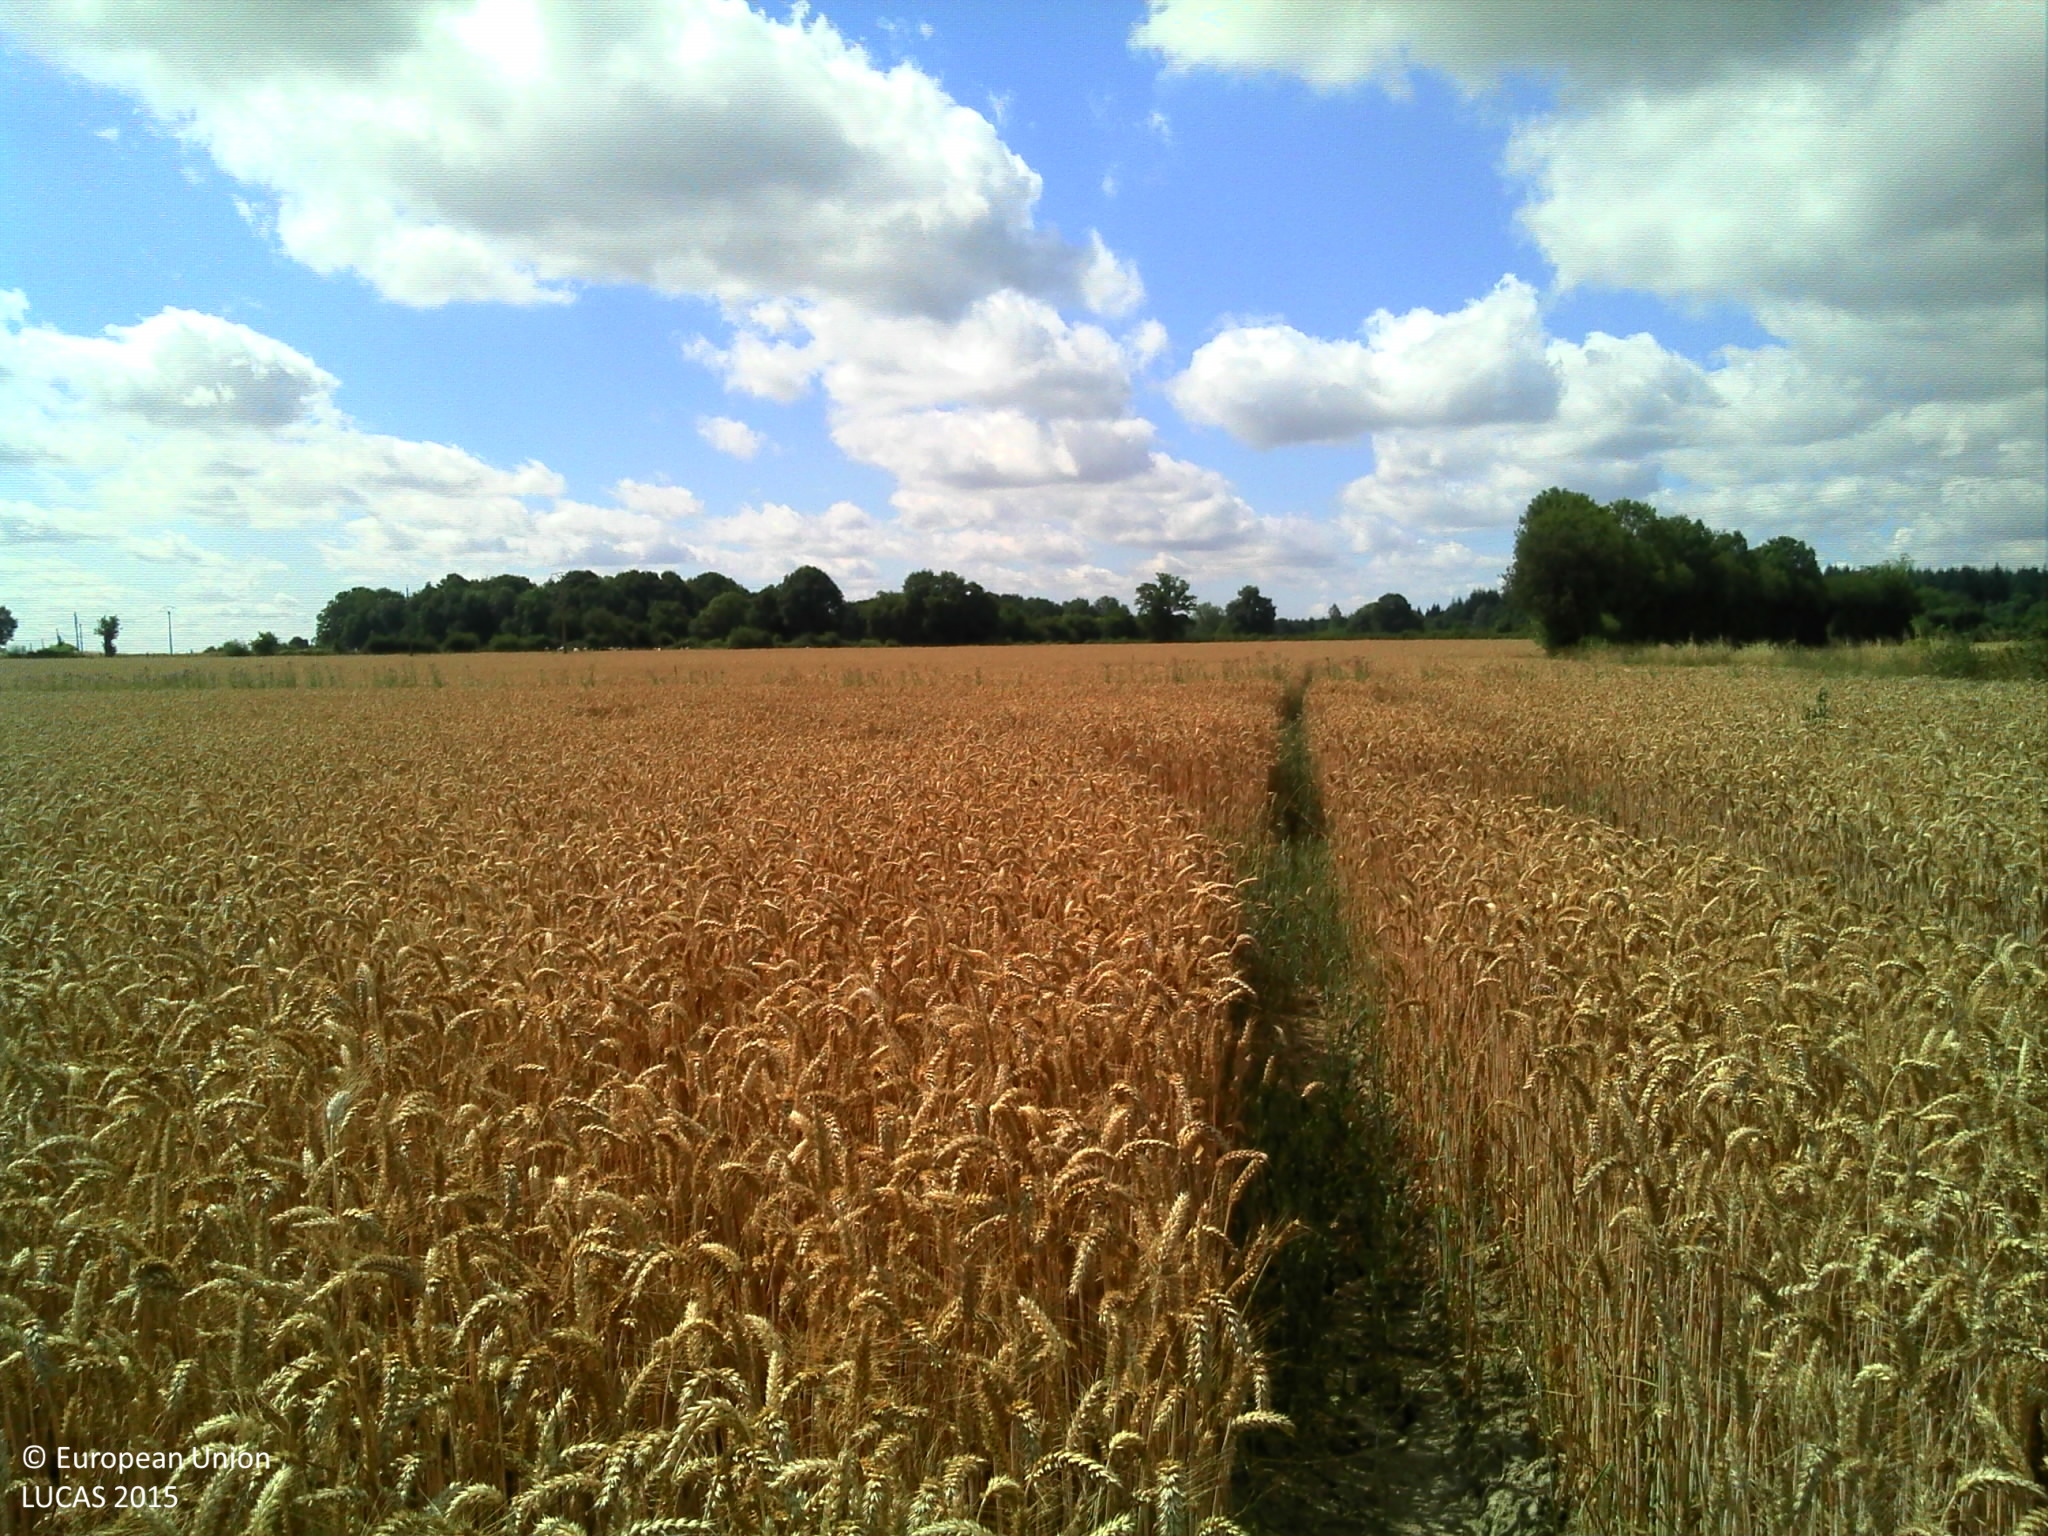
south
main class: Cropland
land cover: Common wheat
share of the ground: > 75 %
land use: Agriculture (excluding fallow land and kitchen gardens)
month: July
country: FR
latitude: 48.8120
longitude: 0.5378
